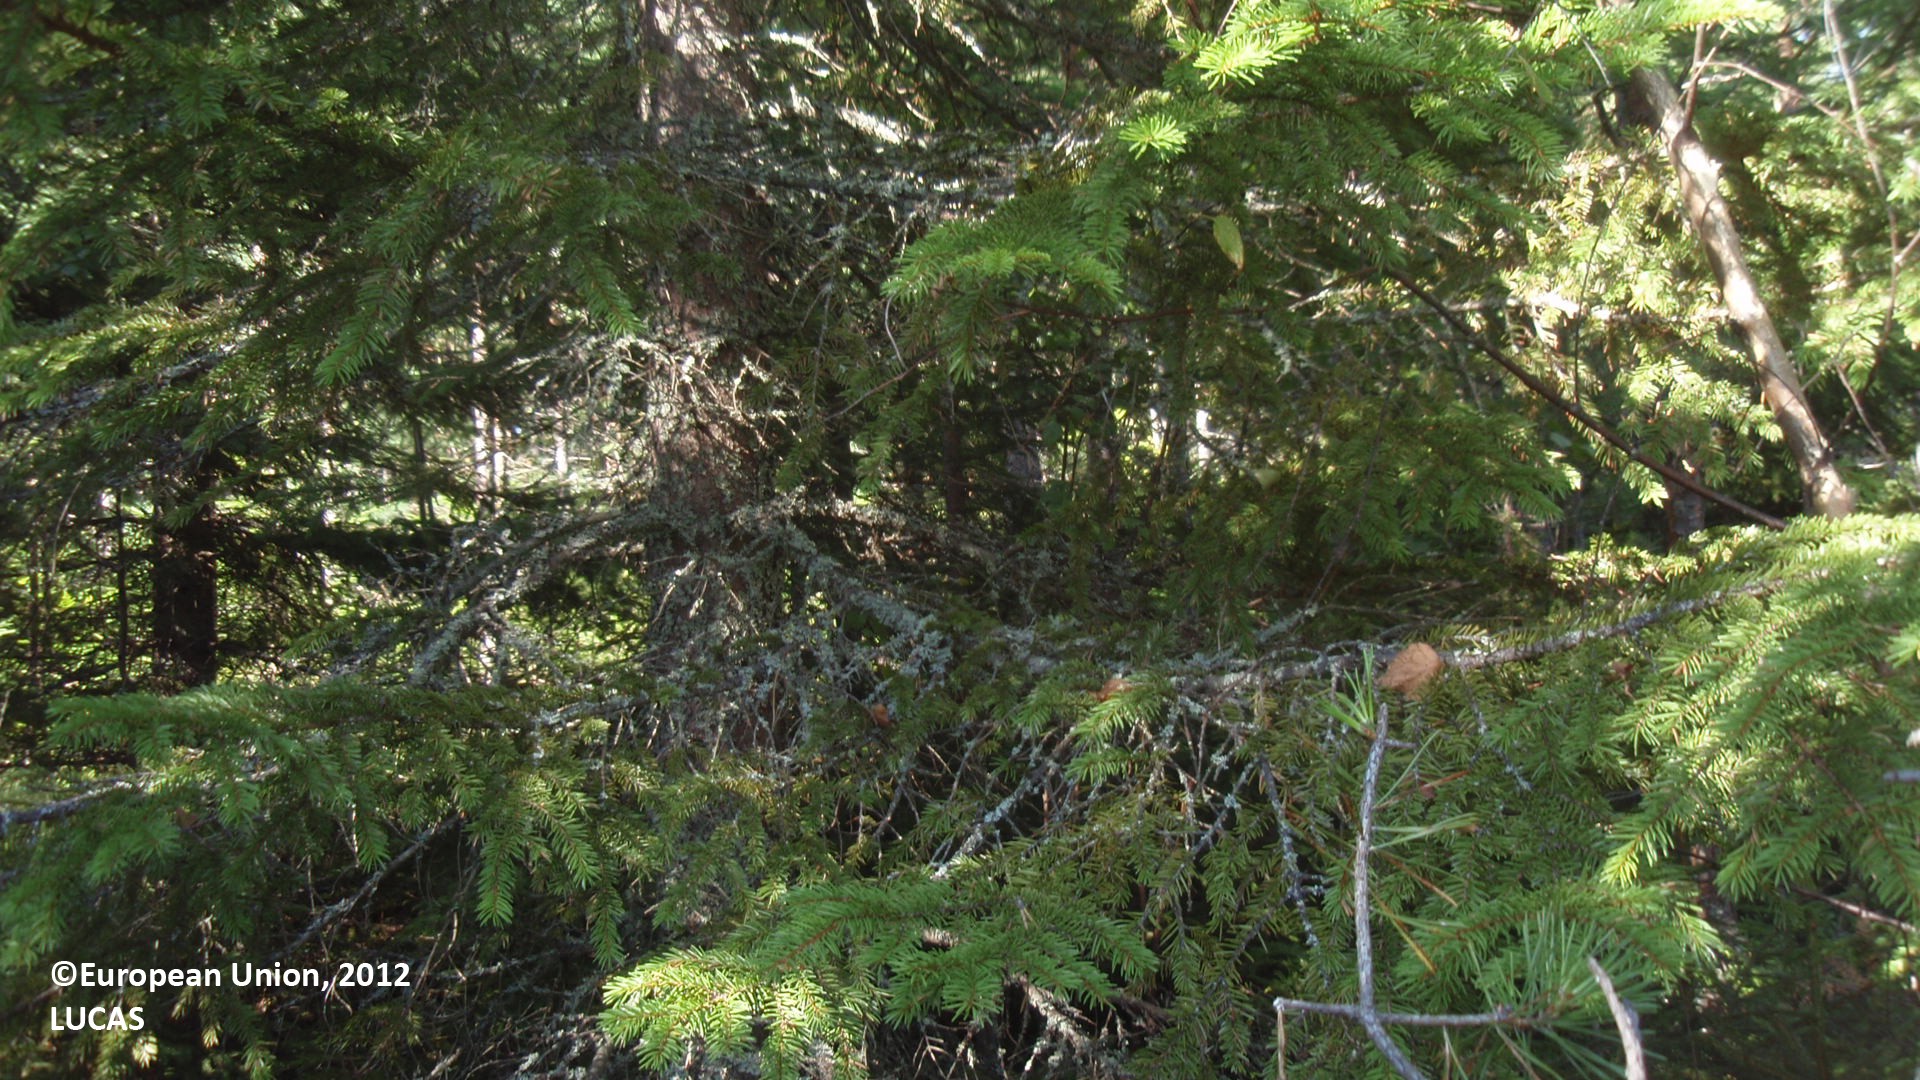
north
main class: Woodland
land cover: Pine dominated mixed woodland
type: boreal forest
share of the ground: 50 - 75 %
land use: Forestry
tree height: > 5 m
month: August
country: FI
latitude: 61.5058
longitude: 27.7547
